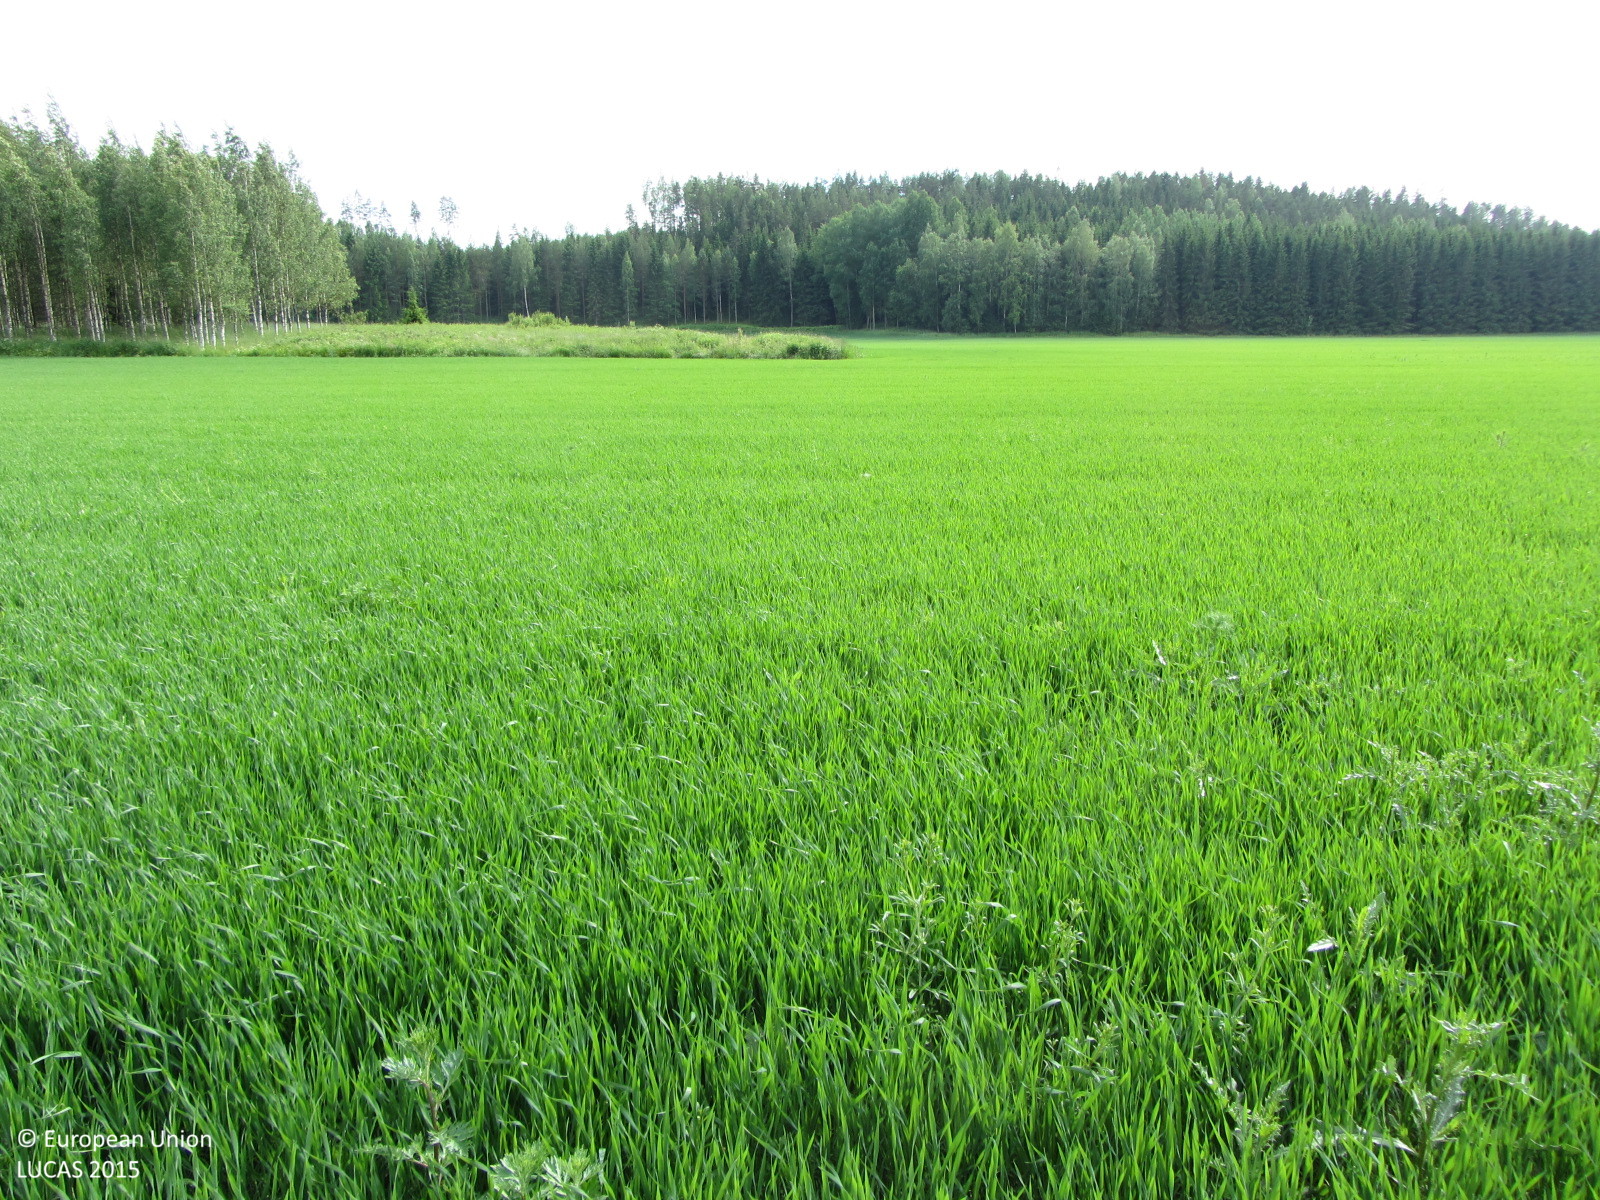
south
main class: Cropland
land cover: Common wheat
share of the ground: > 75 %
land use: Agriculture (excluding fallow land and kitchen gardens)
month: June
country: FI
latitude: 60.0847
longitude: 23.2252
